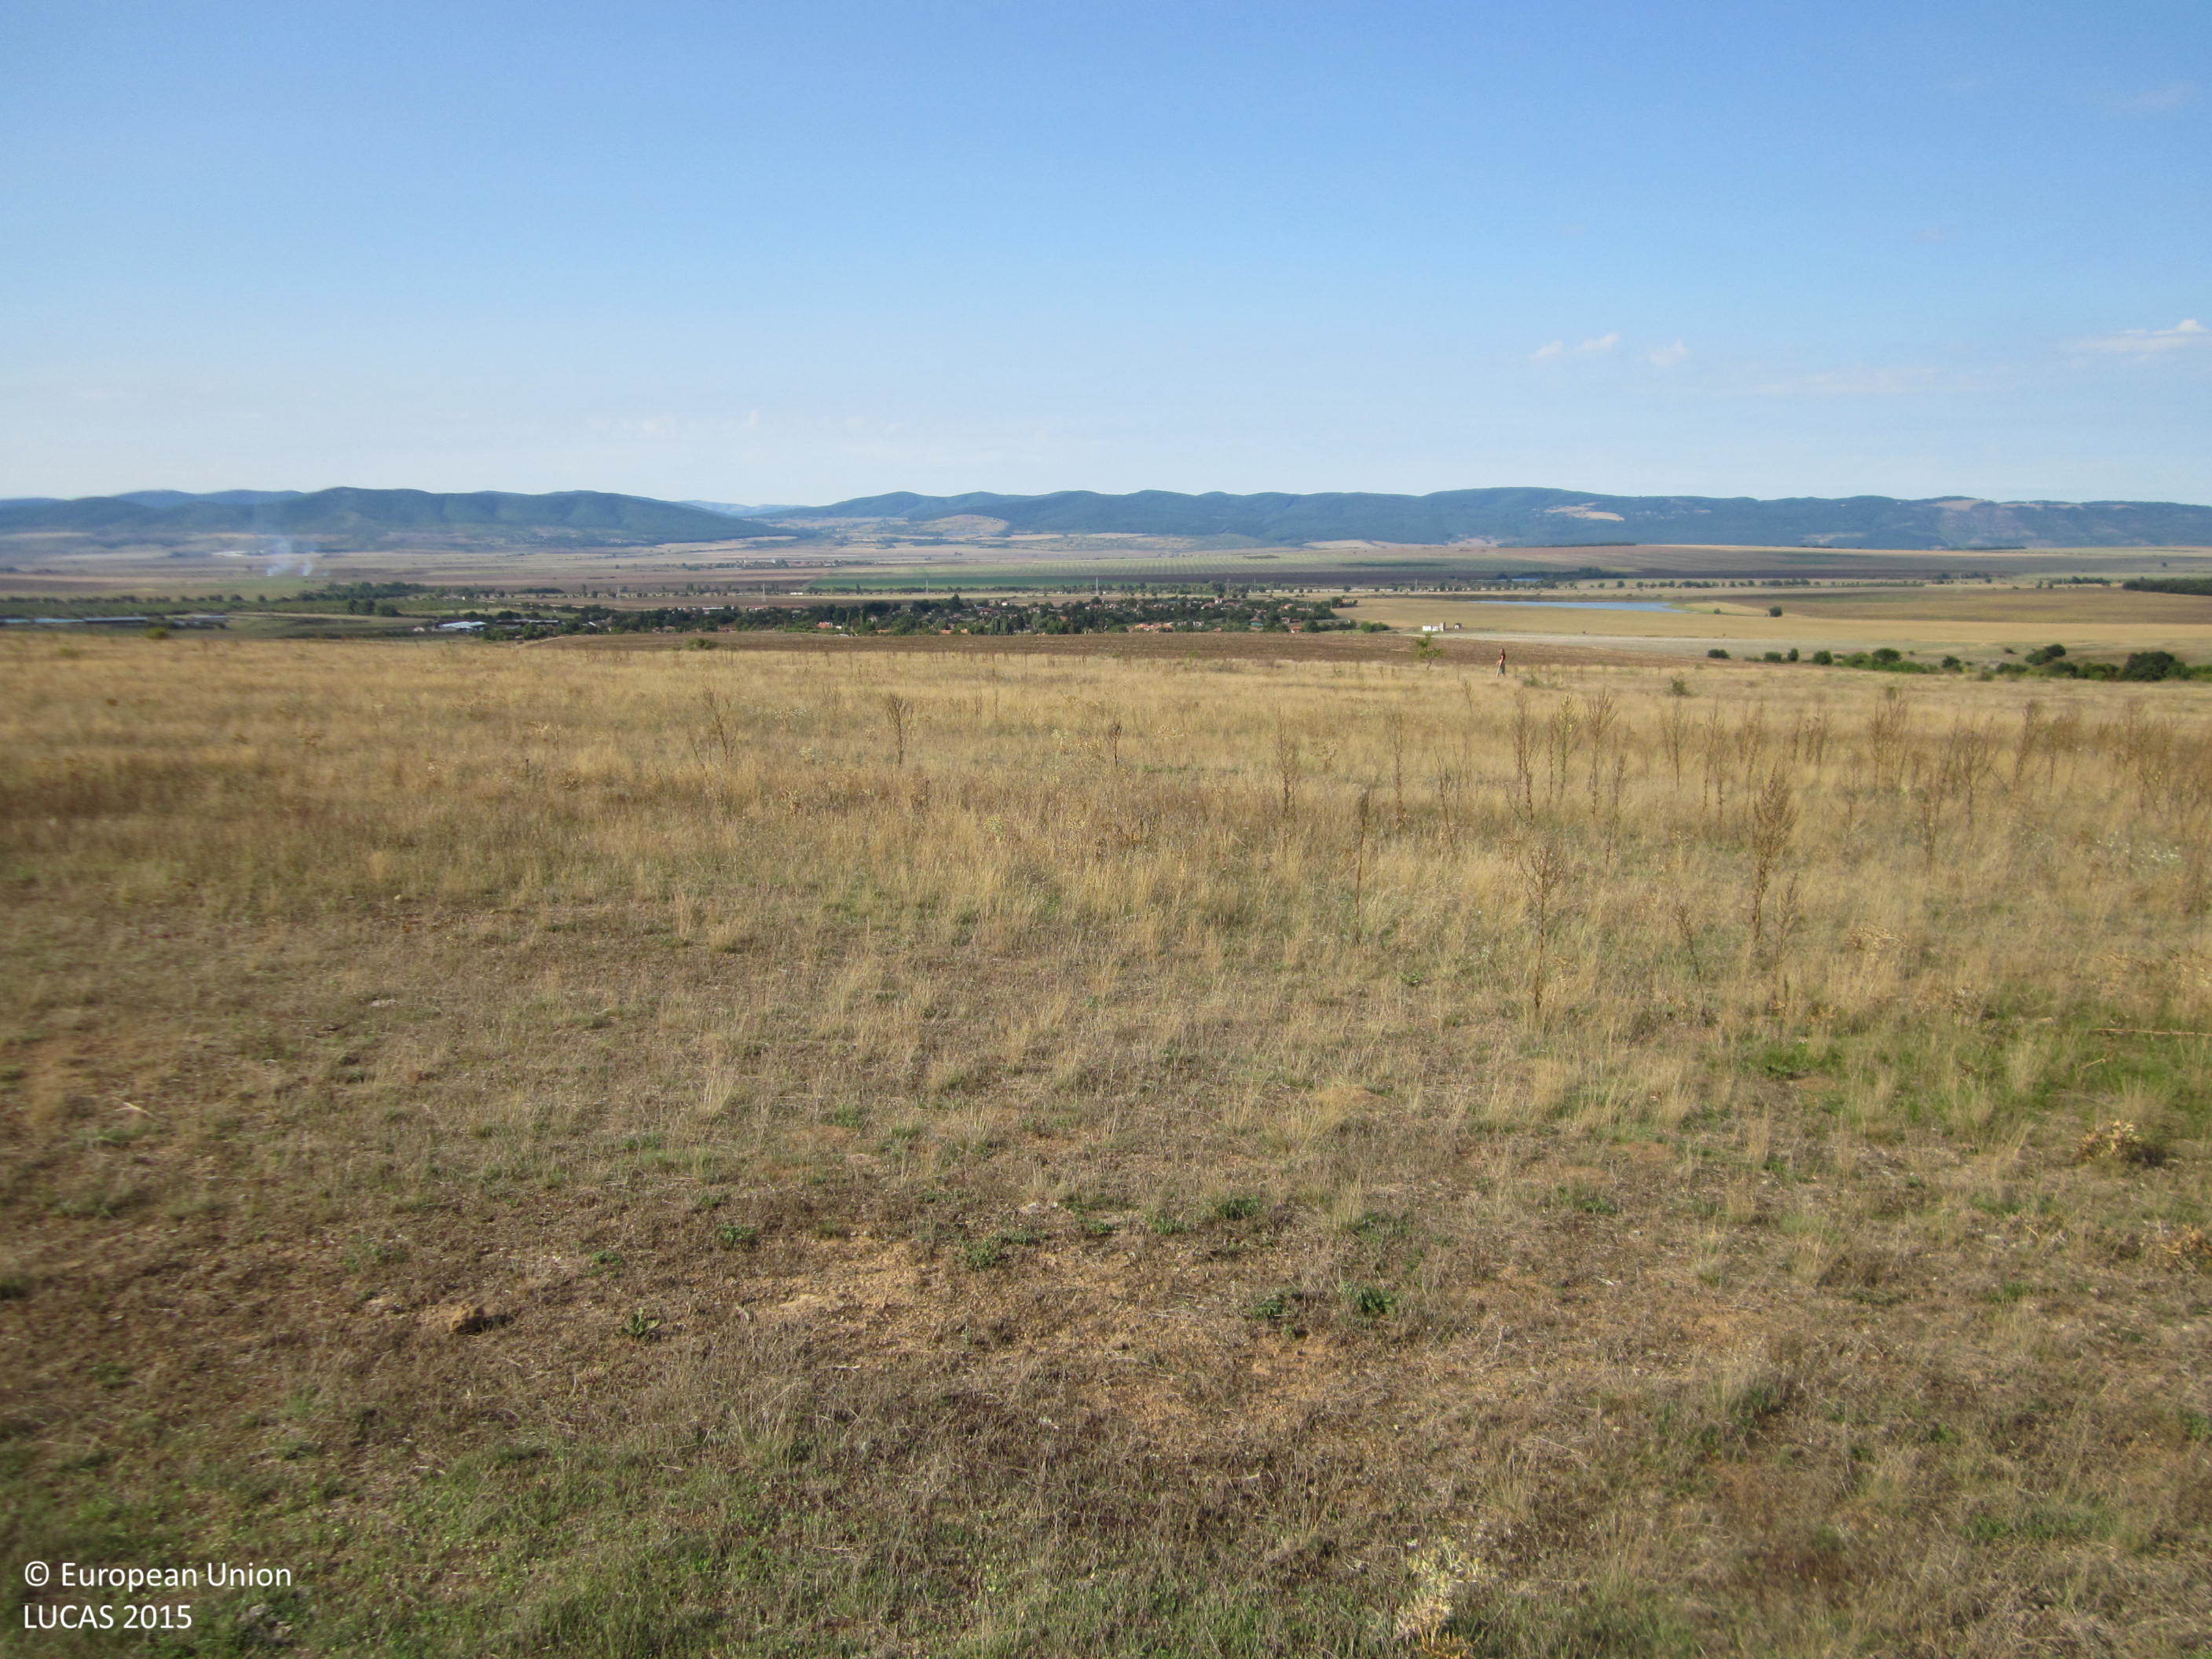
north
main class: Grassland
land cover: Grassland with sparse tree/shrub cover
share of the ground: > 75 %
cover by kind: herbaceous plants 90 %, broadleaved forest trees 5 %, shrubs 5 %
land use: Agriculture (excluding fallow land and kitchen gardens)
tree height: < 5 m
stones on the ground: < 10 %
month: September
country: BG
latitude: 42.6464
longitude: 27.0746
